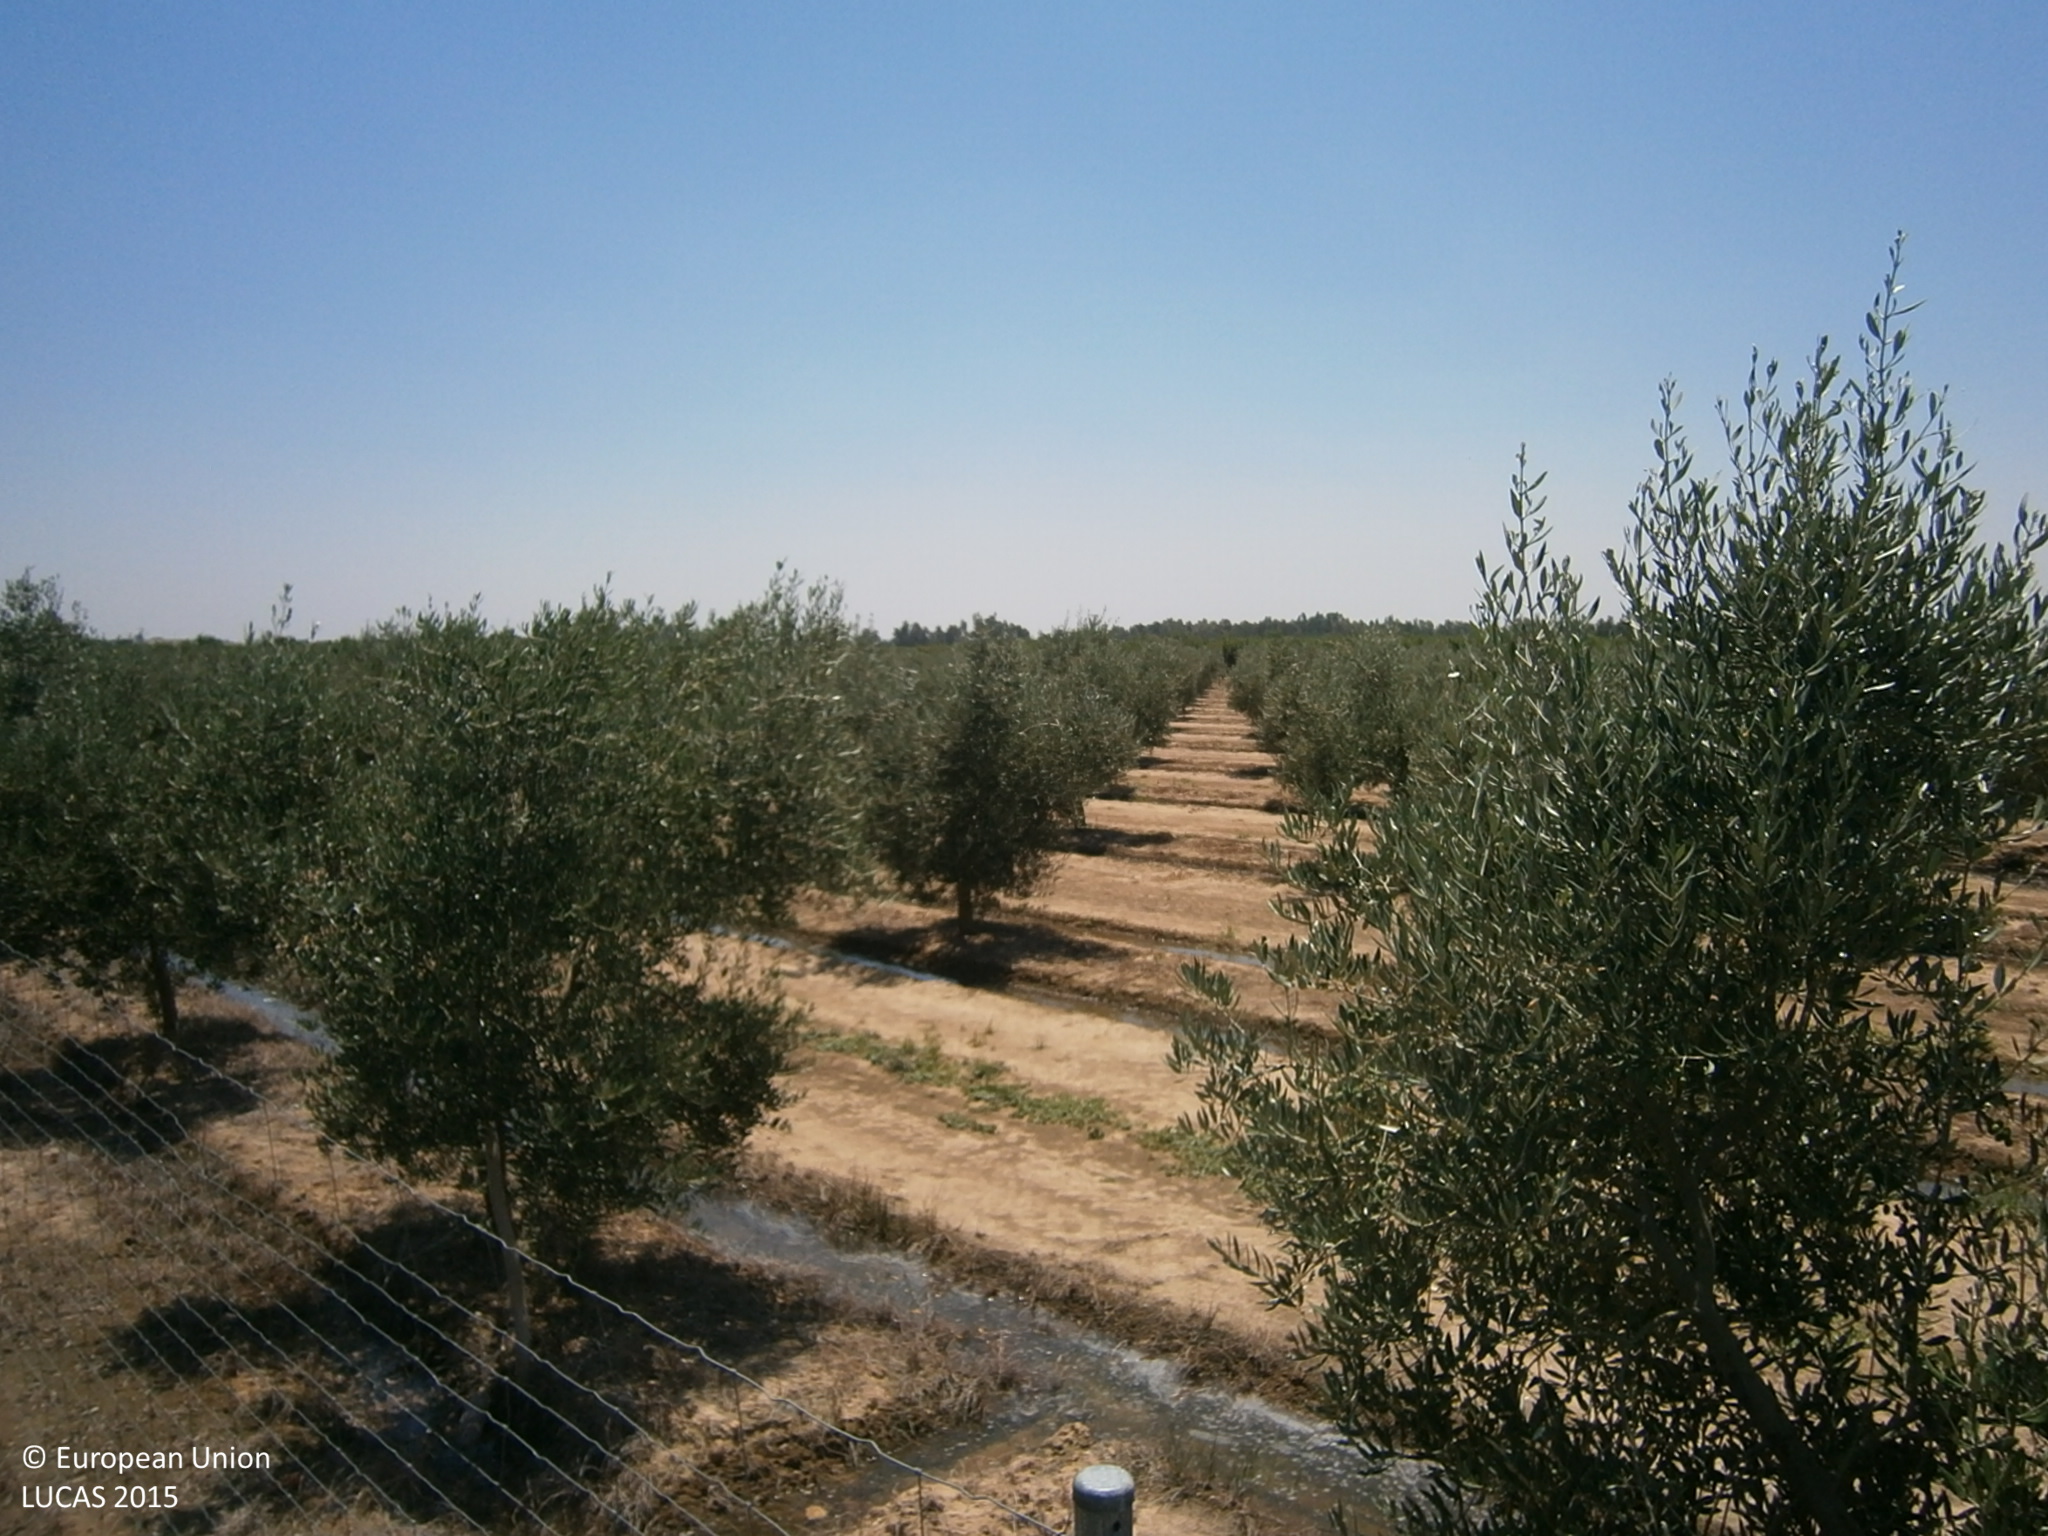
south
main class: Cropland
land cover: Maize
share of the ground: > 75 %
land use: Agriculture (excluding fallow land and kitchen gardens)
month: June
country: ES
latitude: 38.8802
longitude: -6.6980
